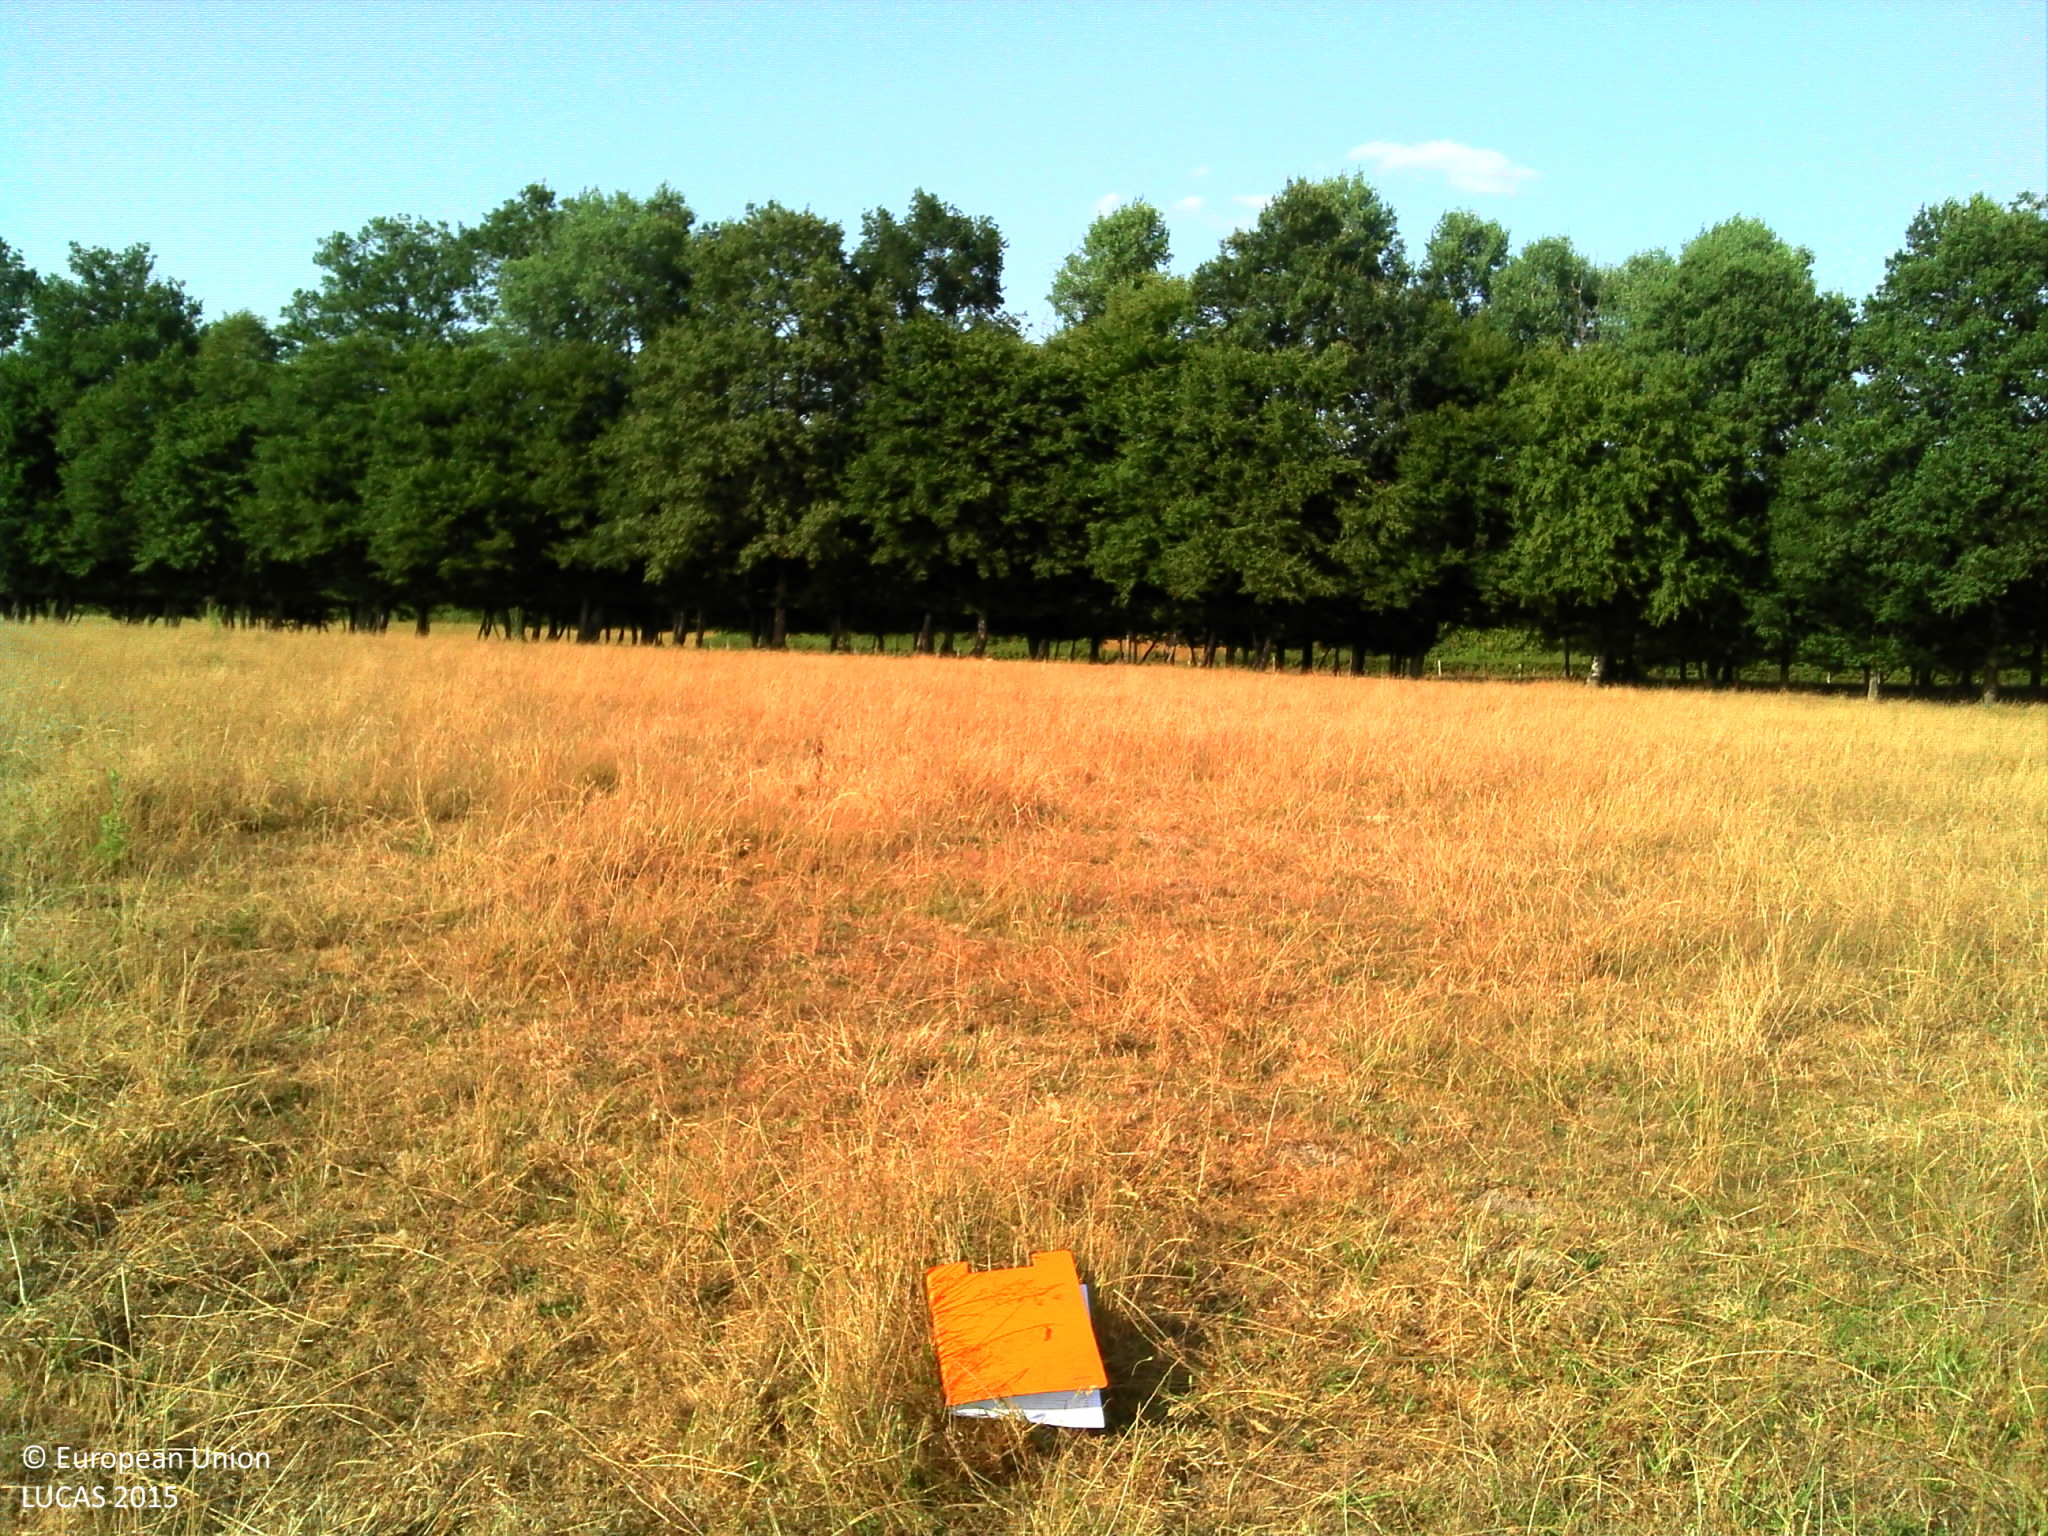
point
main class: Grassland
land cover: Grassland without tree/shrub cover
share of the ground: > 75 %
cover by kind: herbaceous plants 100 %
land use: Agriculture (excluding fallow land and kitchen gardens)
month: July
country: FR
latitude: 46.8123
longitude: 3.6423
